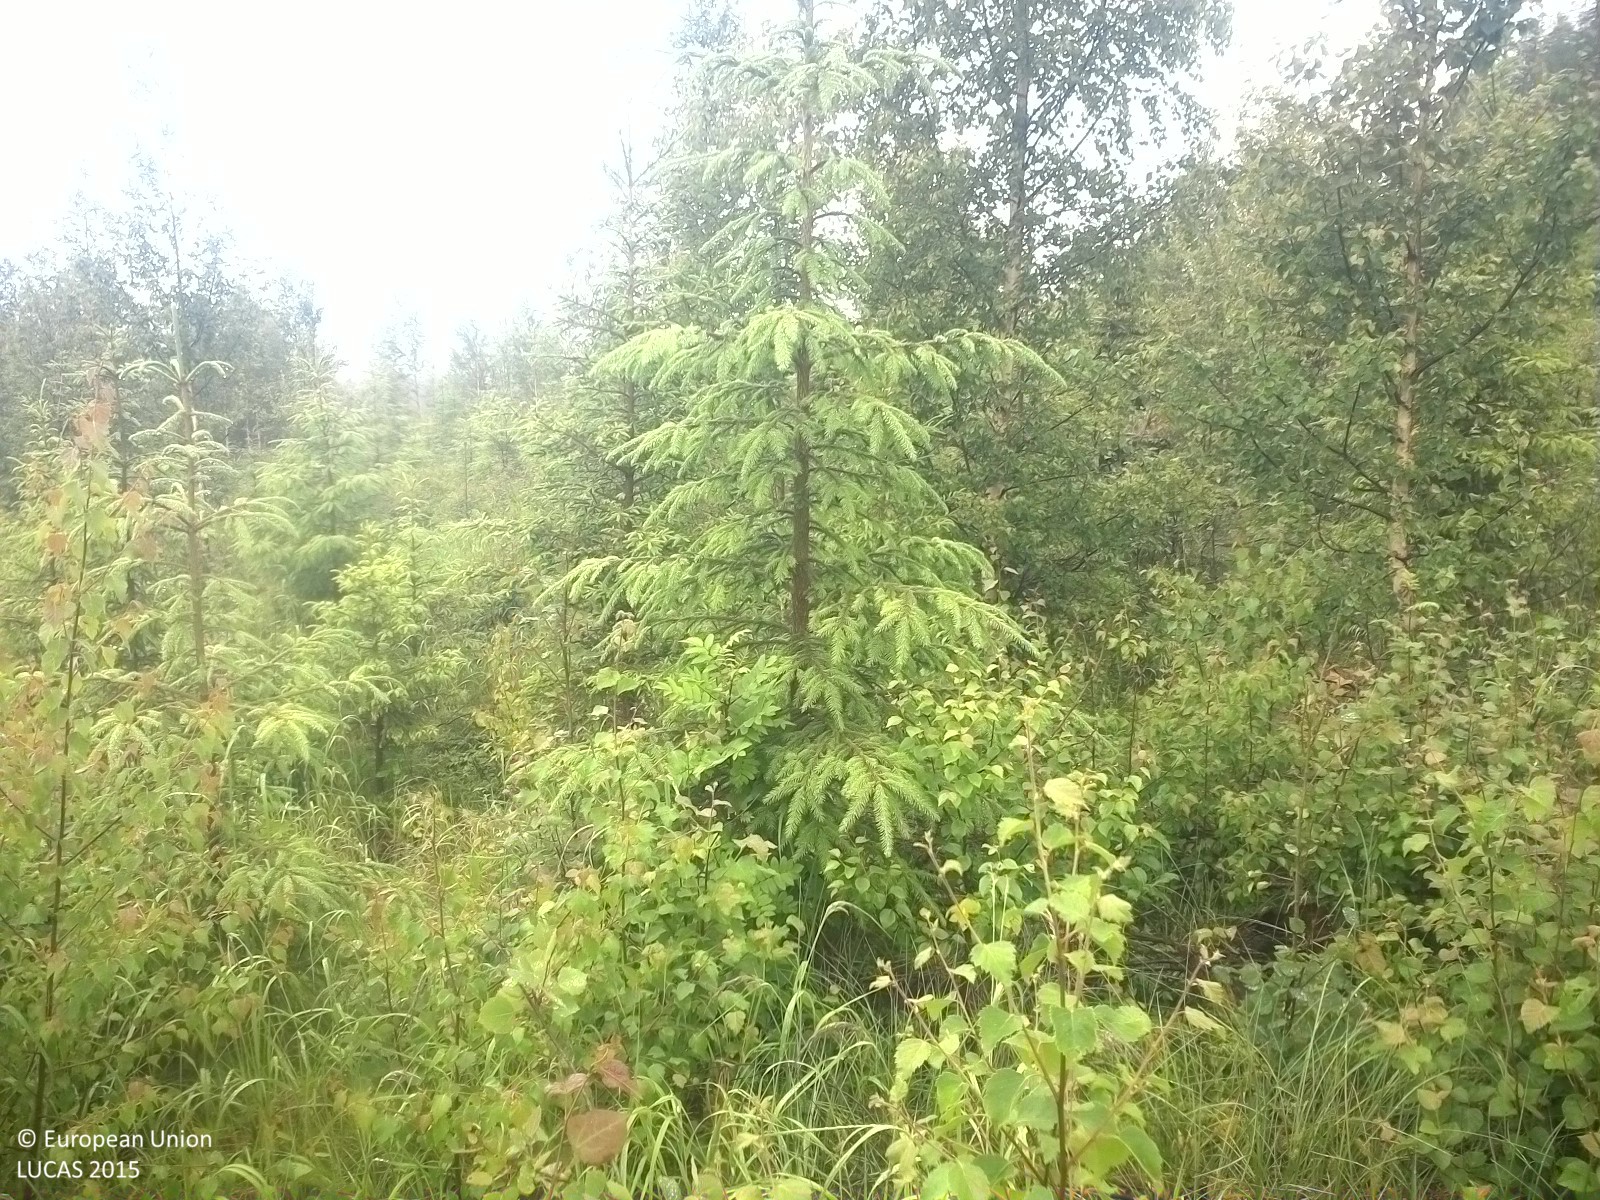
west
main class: Woodland
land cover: Spruce dominated mixed woodland
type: boreal forest
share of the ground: 50 - 75 %
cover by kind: herbaceous plants 45 %, coniferous forest trees 35 %, broadleaved forest trees 20 %
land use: Forestry
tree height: < 5 m
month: July
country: SE
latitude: 62.5277
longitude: 16.8771
